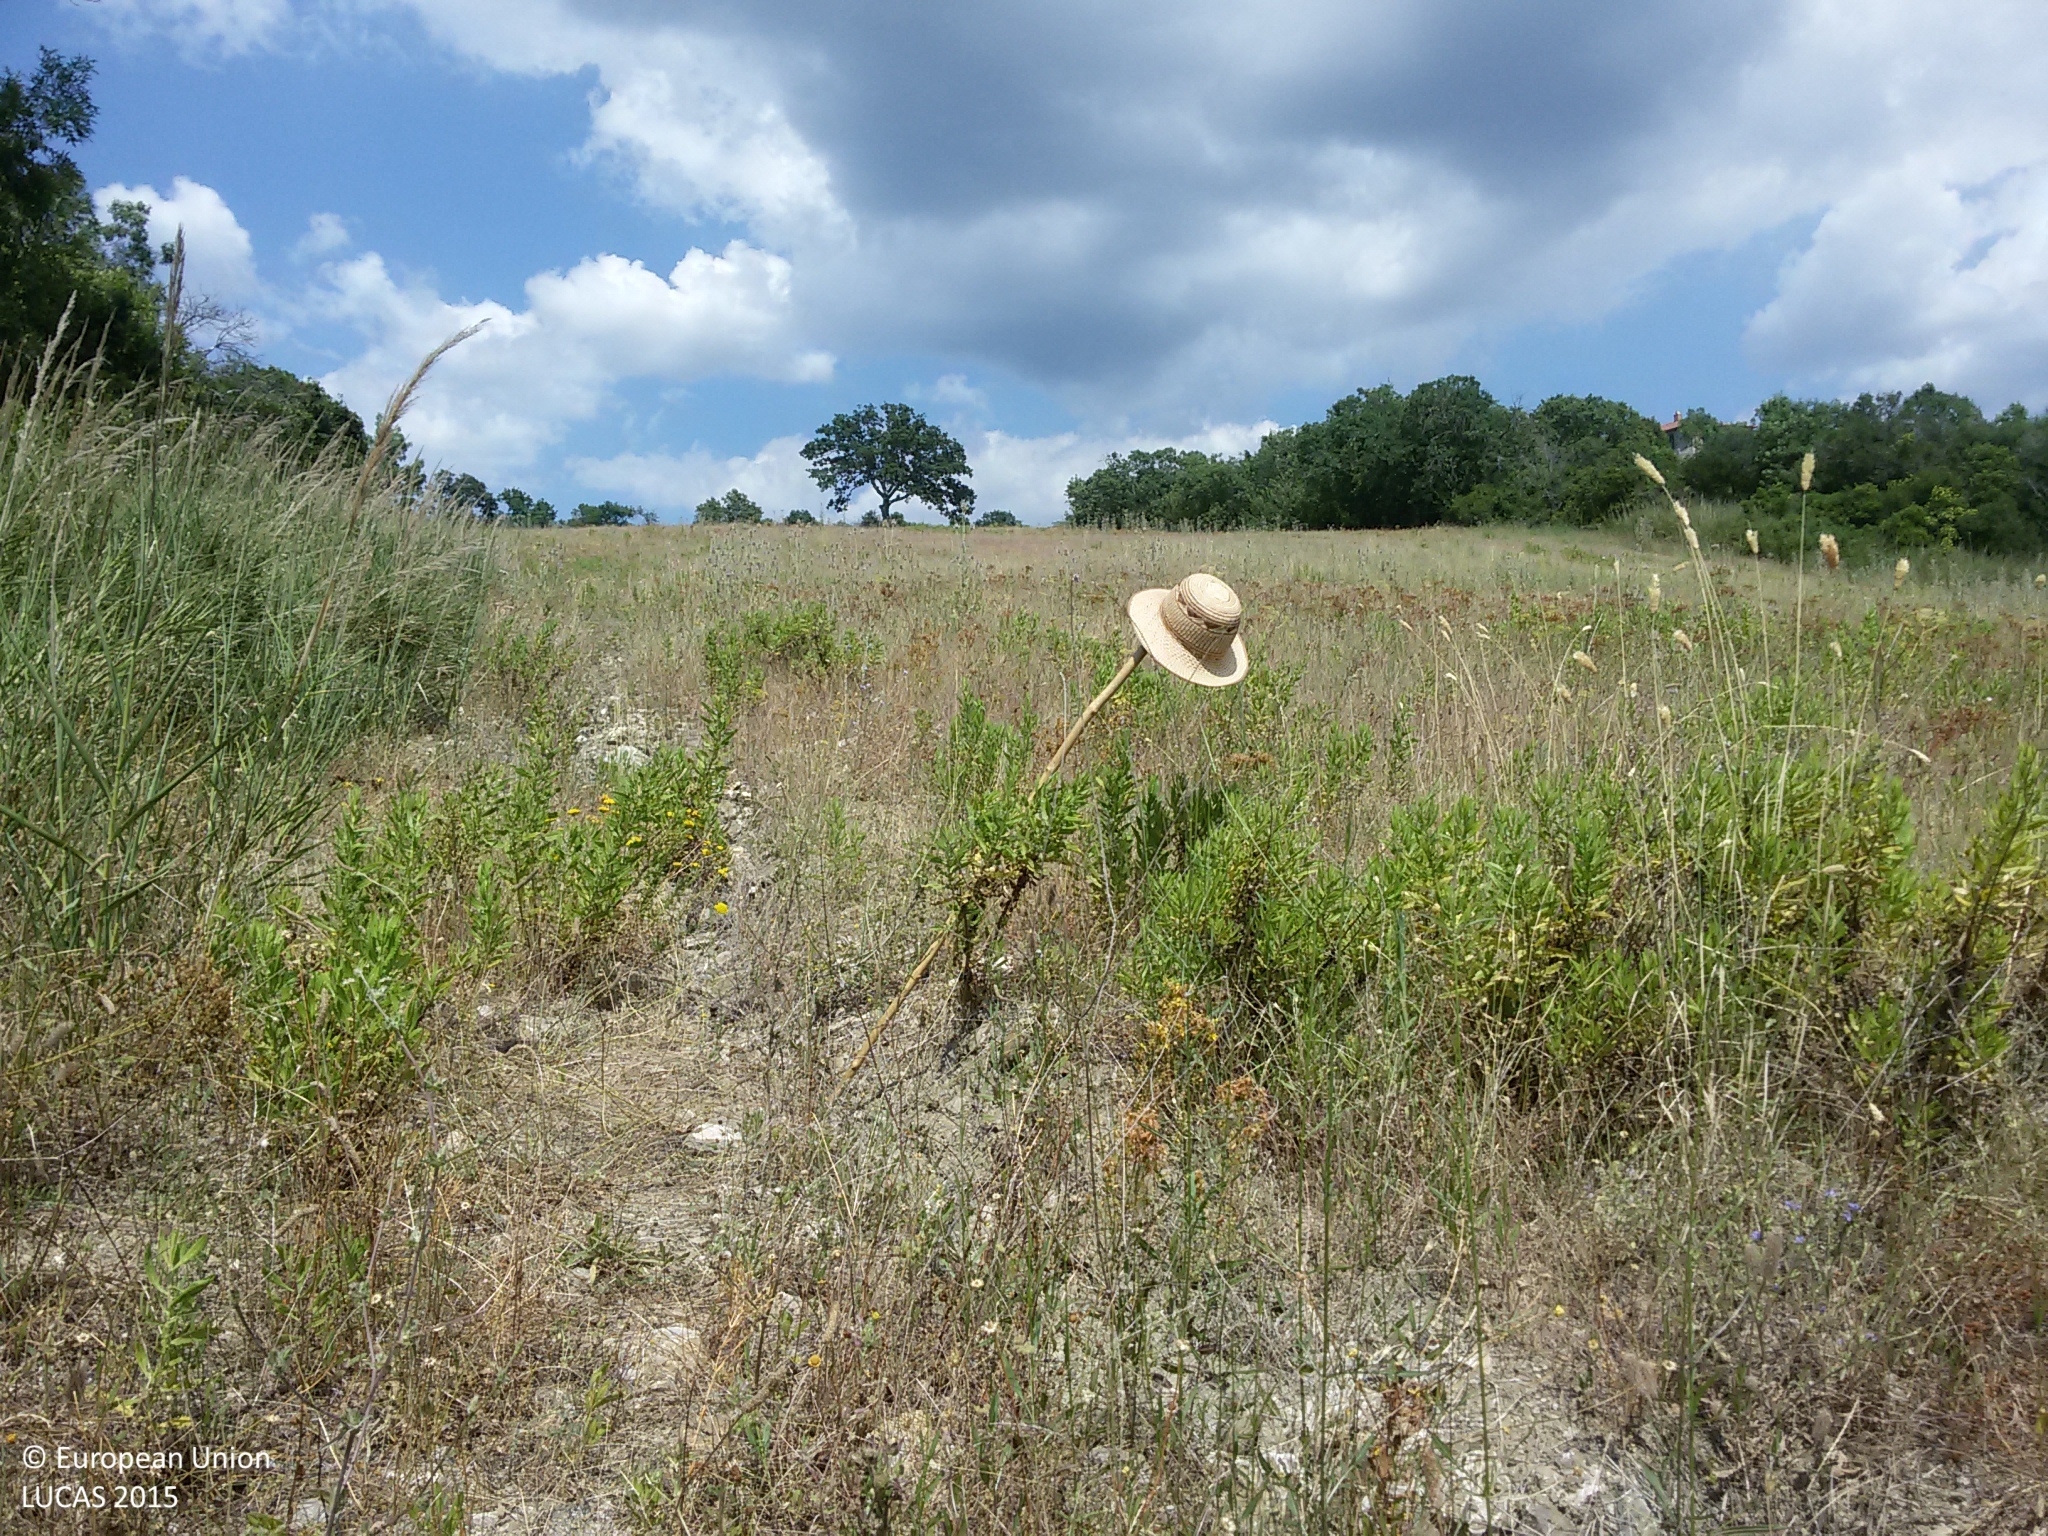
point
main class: Grassland
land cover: Grassland without tree/shrub cover
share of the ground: 50 - 75 %
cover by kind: herbaceous plants 90 %, consolidated bare surface 5 %, unconsolidated bare surface 5 %
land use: Agriculture (excluding fallow land and kitchen gardens)
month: July
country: IT
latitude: 42.7156
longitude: 11.4726
